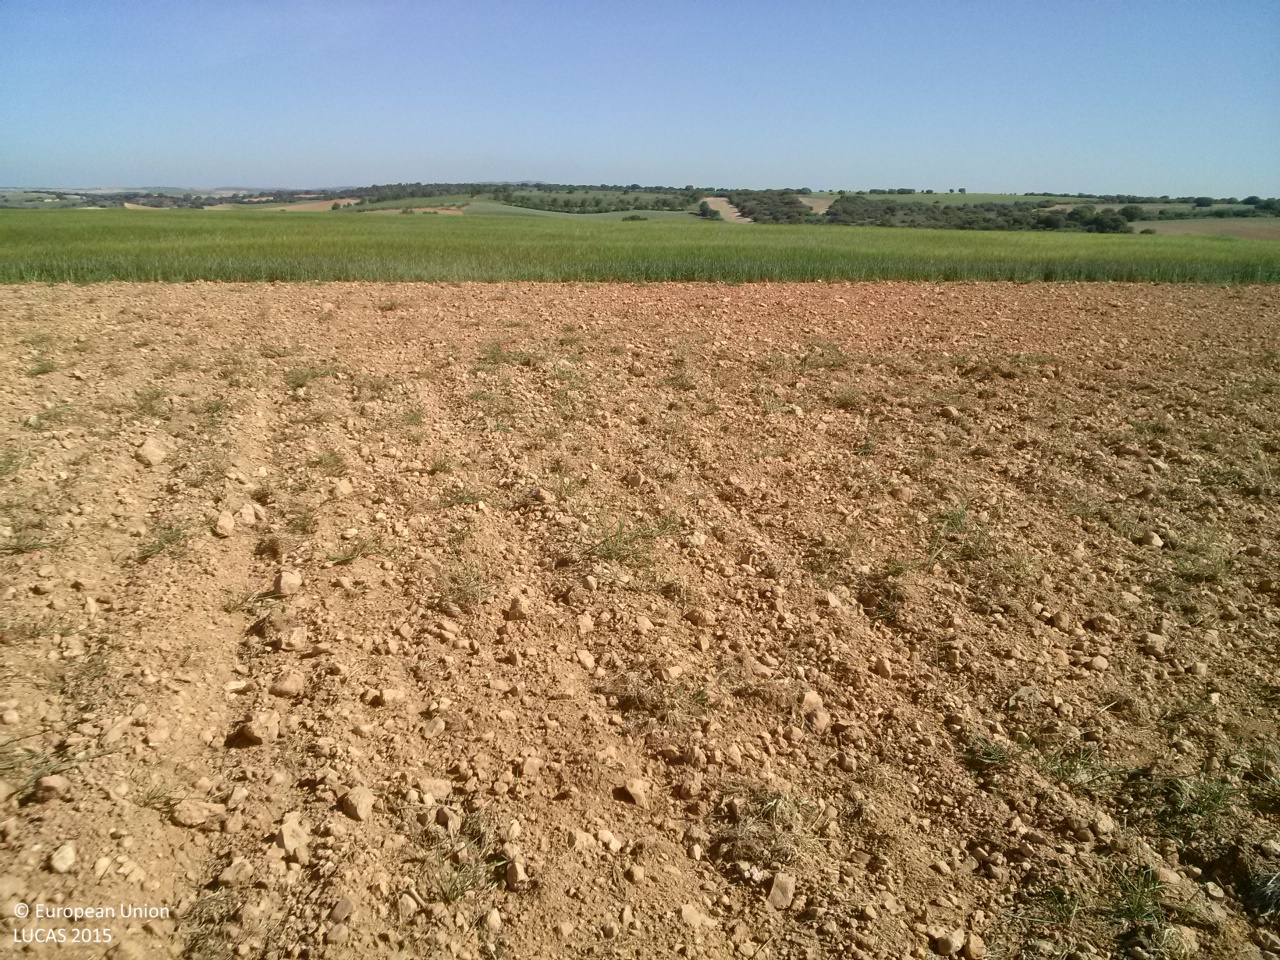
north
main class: Grassland
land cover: Spontaneously vegetated surfaces
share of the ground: 10 - 25 %
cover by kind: unconsolidated bare surface 85 %, herbaceous plants 15 %
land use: Fallow land
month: May
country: ES
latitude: 39.8468
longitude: -2.7935
